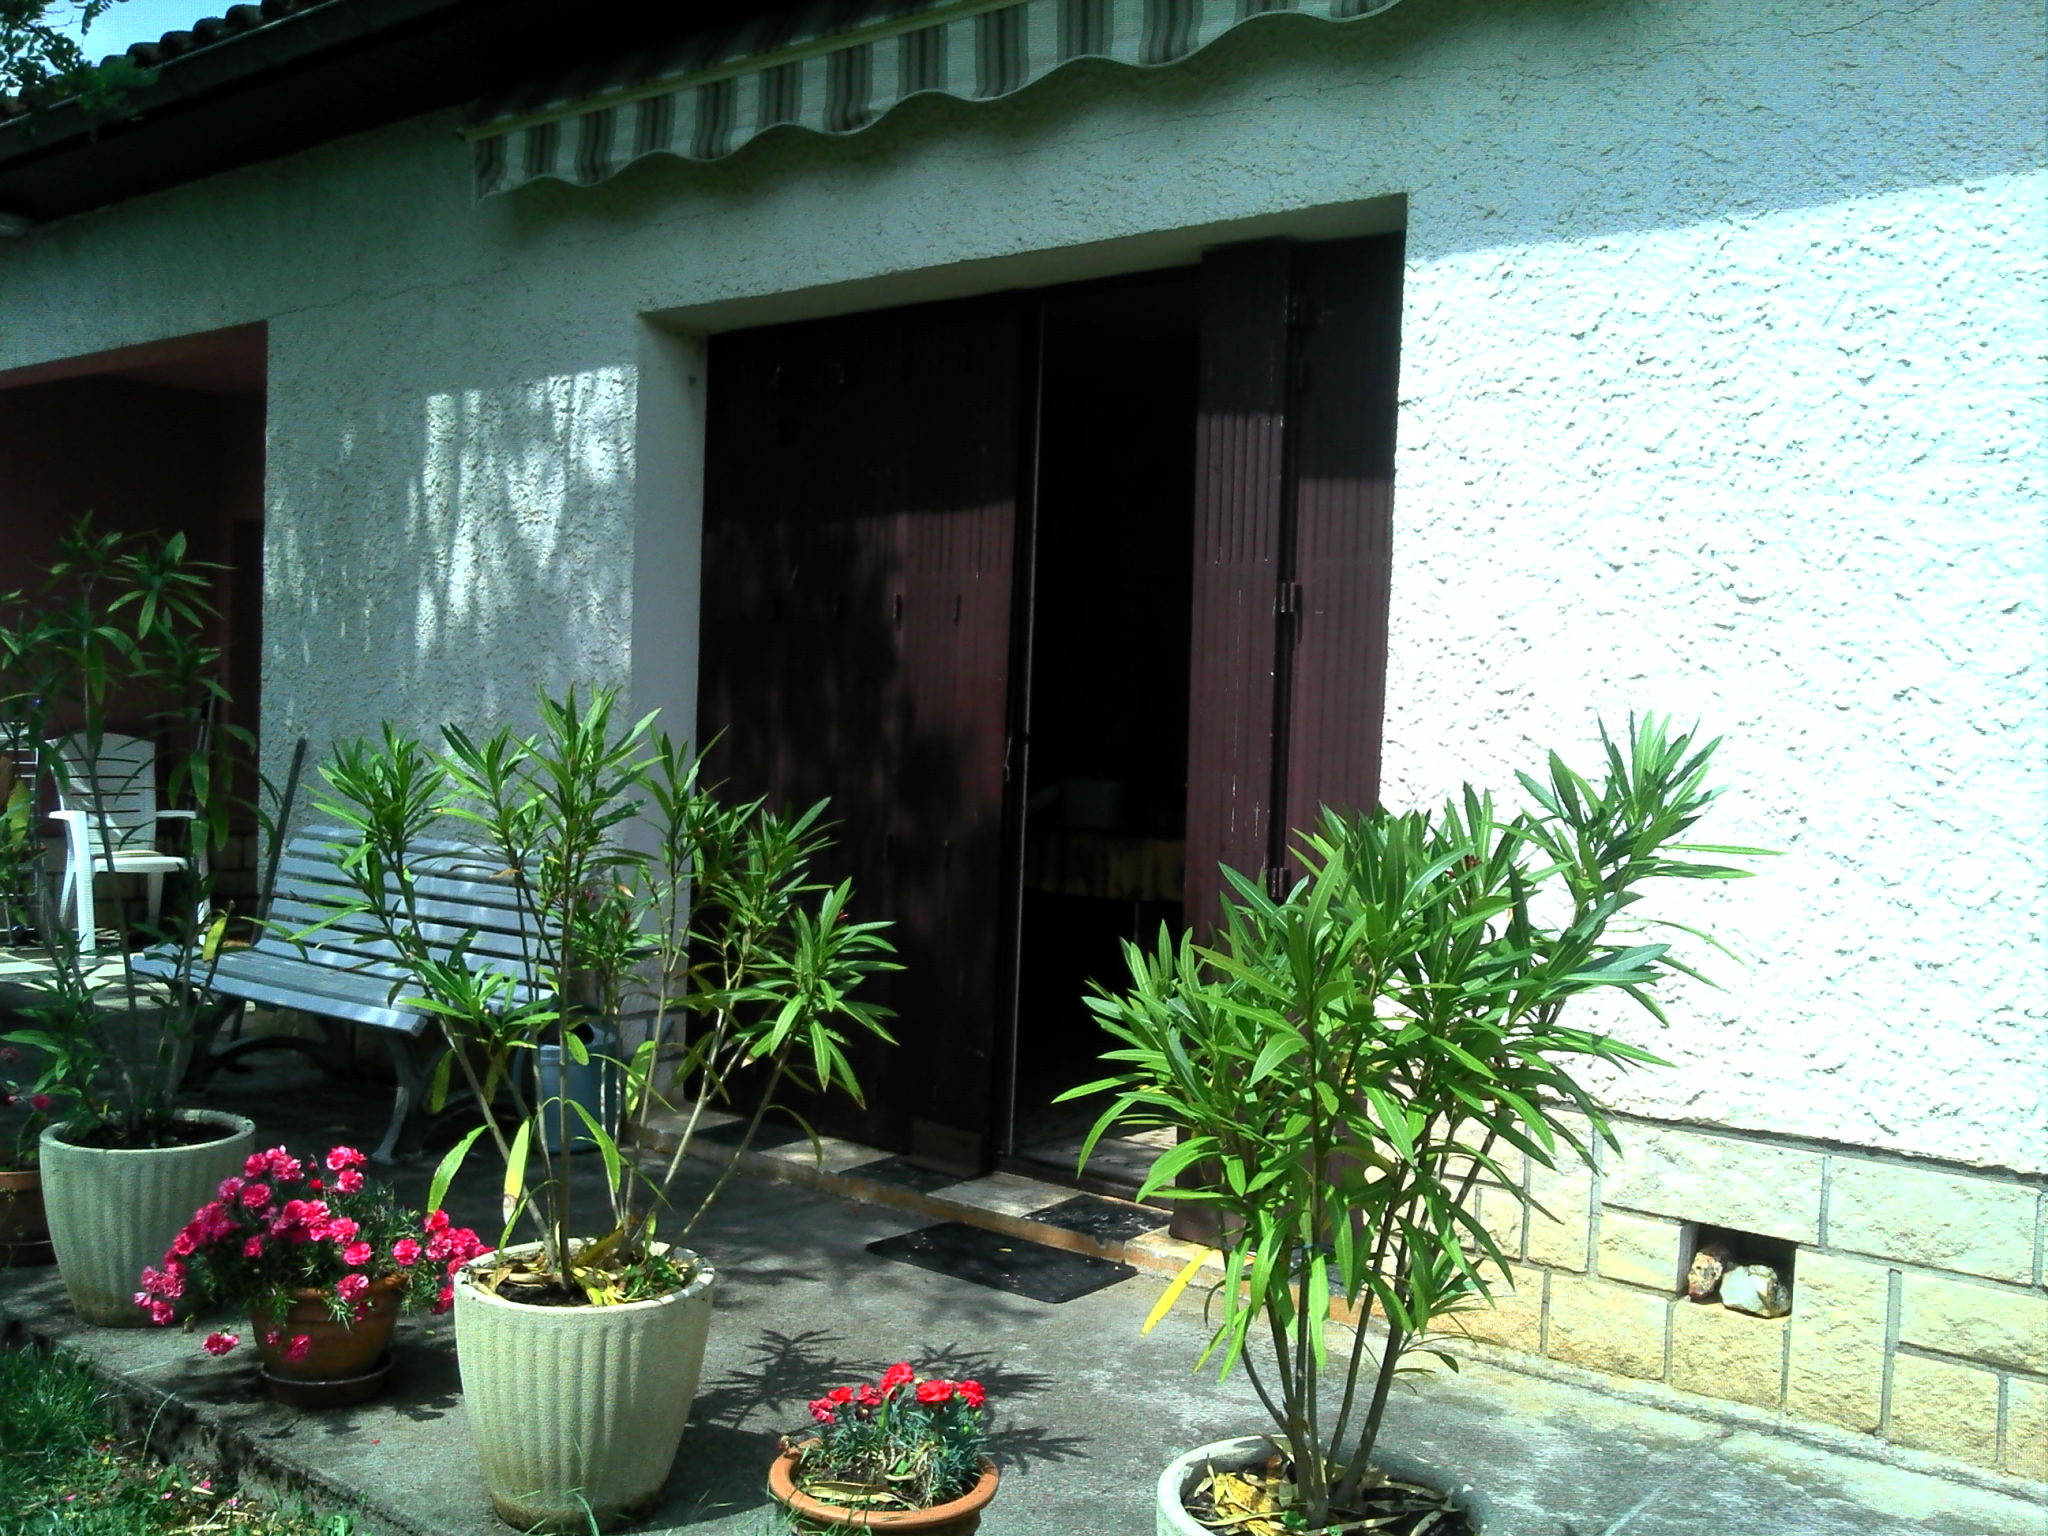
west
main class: Grassland
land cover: Grassland without tree/shrub cover
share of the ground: > 75 %
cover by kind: herbaceous plants 100 %
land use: Residential
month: June
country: FR
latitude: 44.6251
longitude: 1.8192
